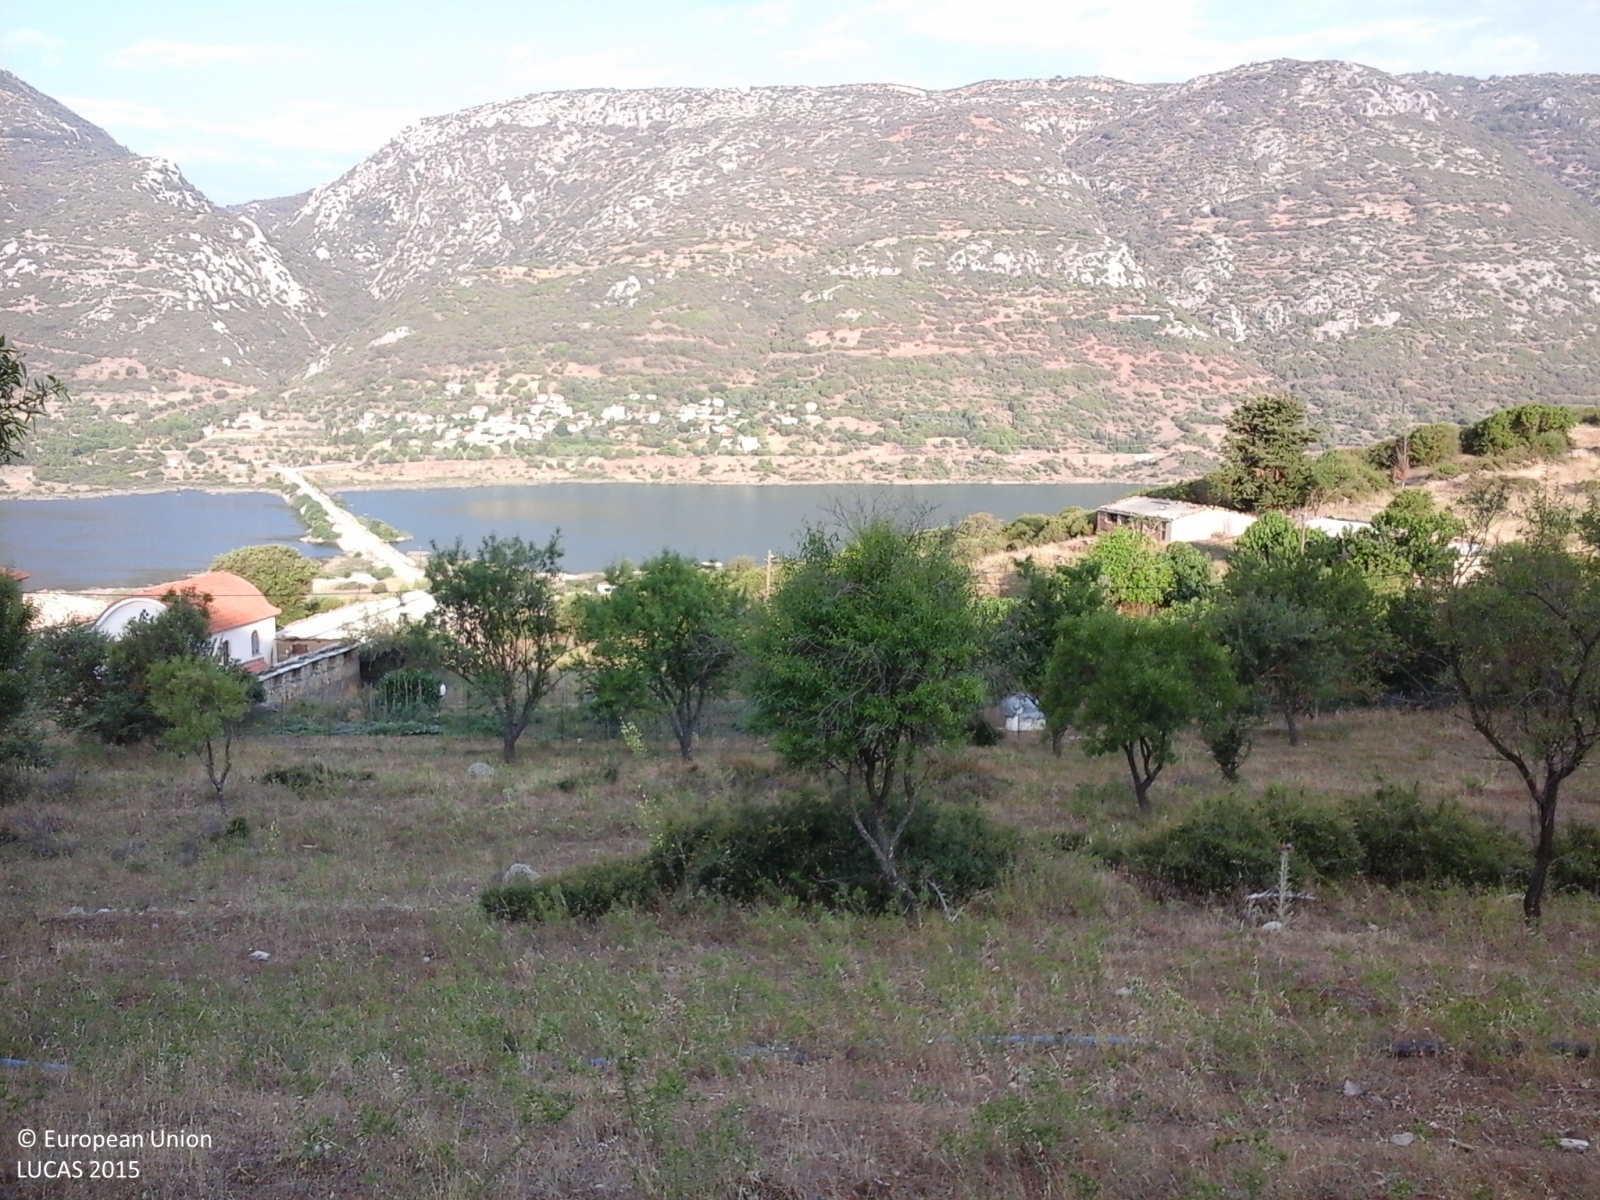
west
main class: Grassland
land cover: Grassland with sparse tree/shrub cover
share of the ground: > 75 %
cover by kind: herbaceous plants 60 %, unconsolidated bare surface 25 %, shrubs 10 %, broadleaved forest trees 5 %
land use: Agriculture (excluding fallow land and kitchen gardens)
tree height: < 5 m
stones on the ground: 10 - 25 %
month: July
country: GR
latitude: 38.4960
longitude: 22.2077
